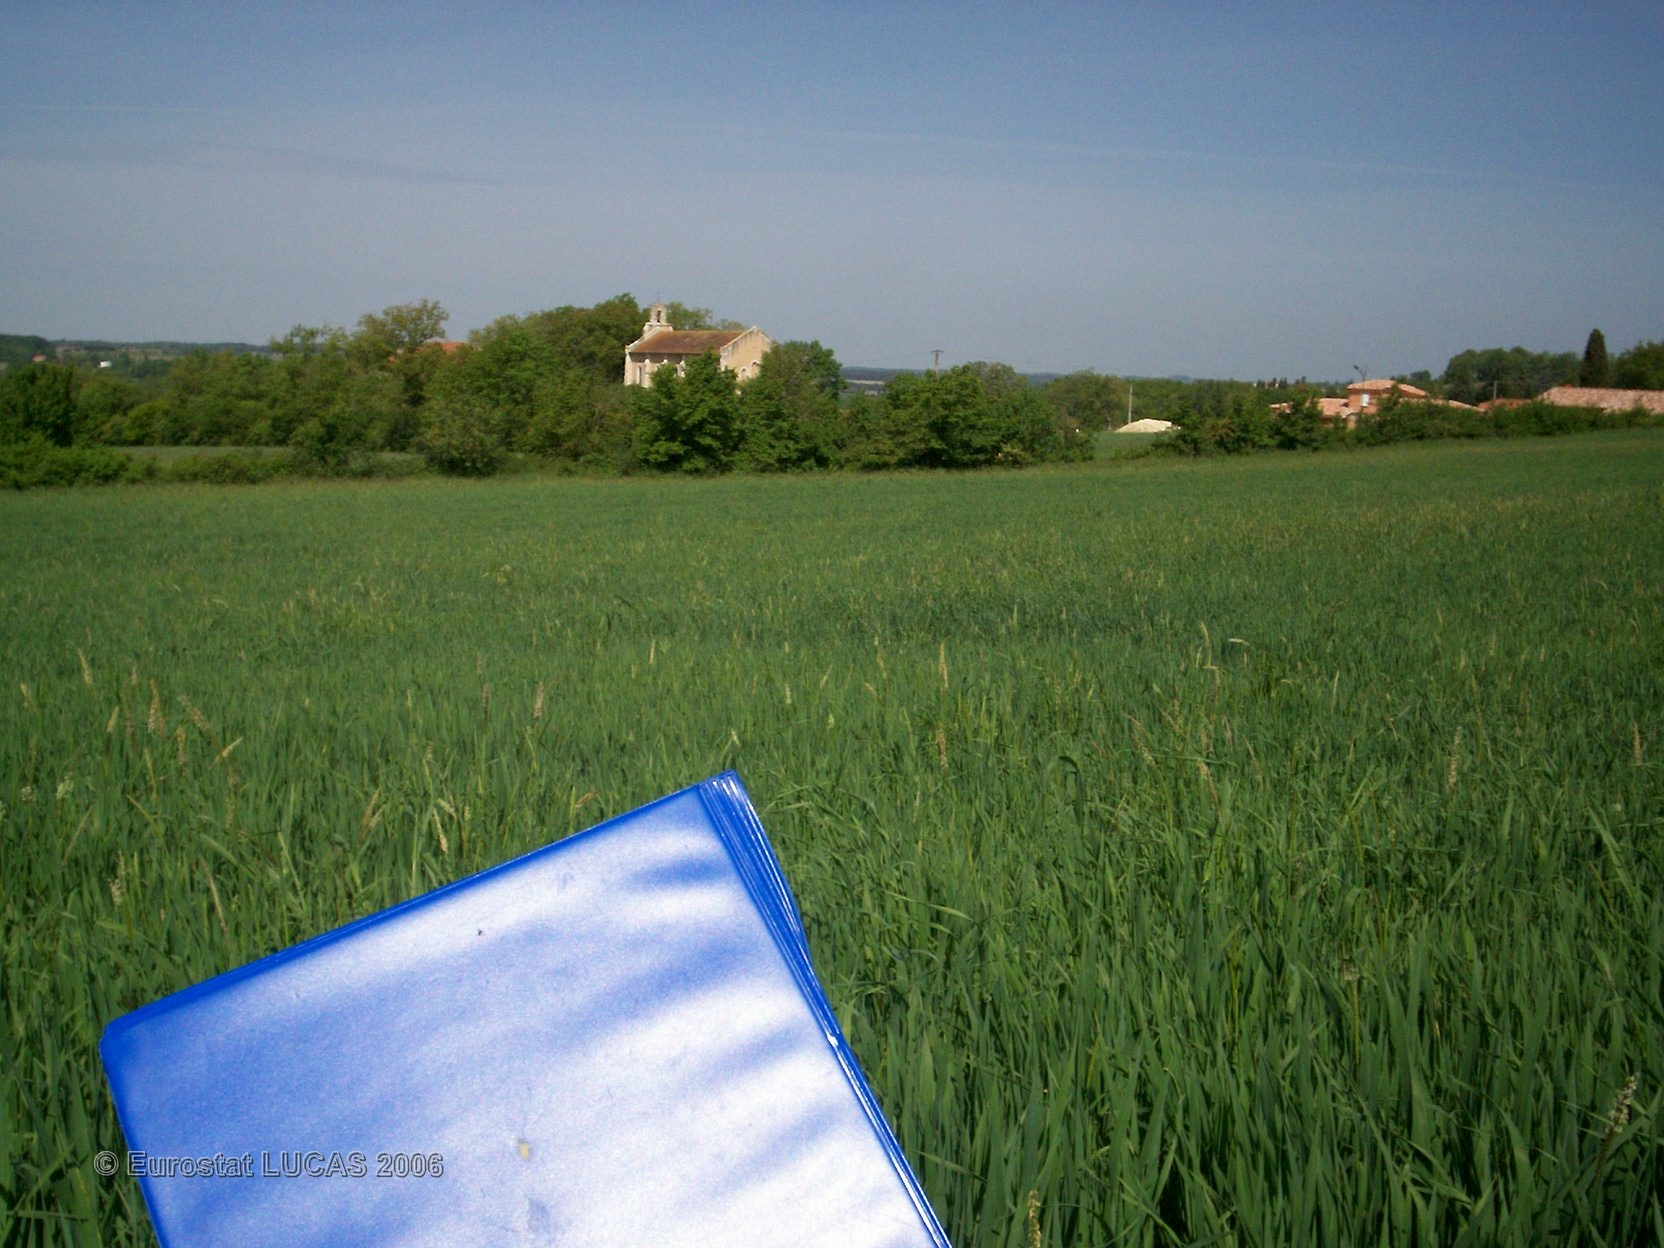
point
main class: Cropland
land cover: Oats
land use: Agriculture (excluding fallow land and kitchen gardens)
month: May
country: FR
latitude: 43.8365
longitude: 0.2564
